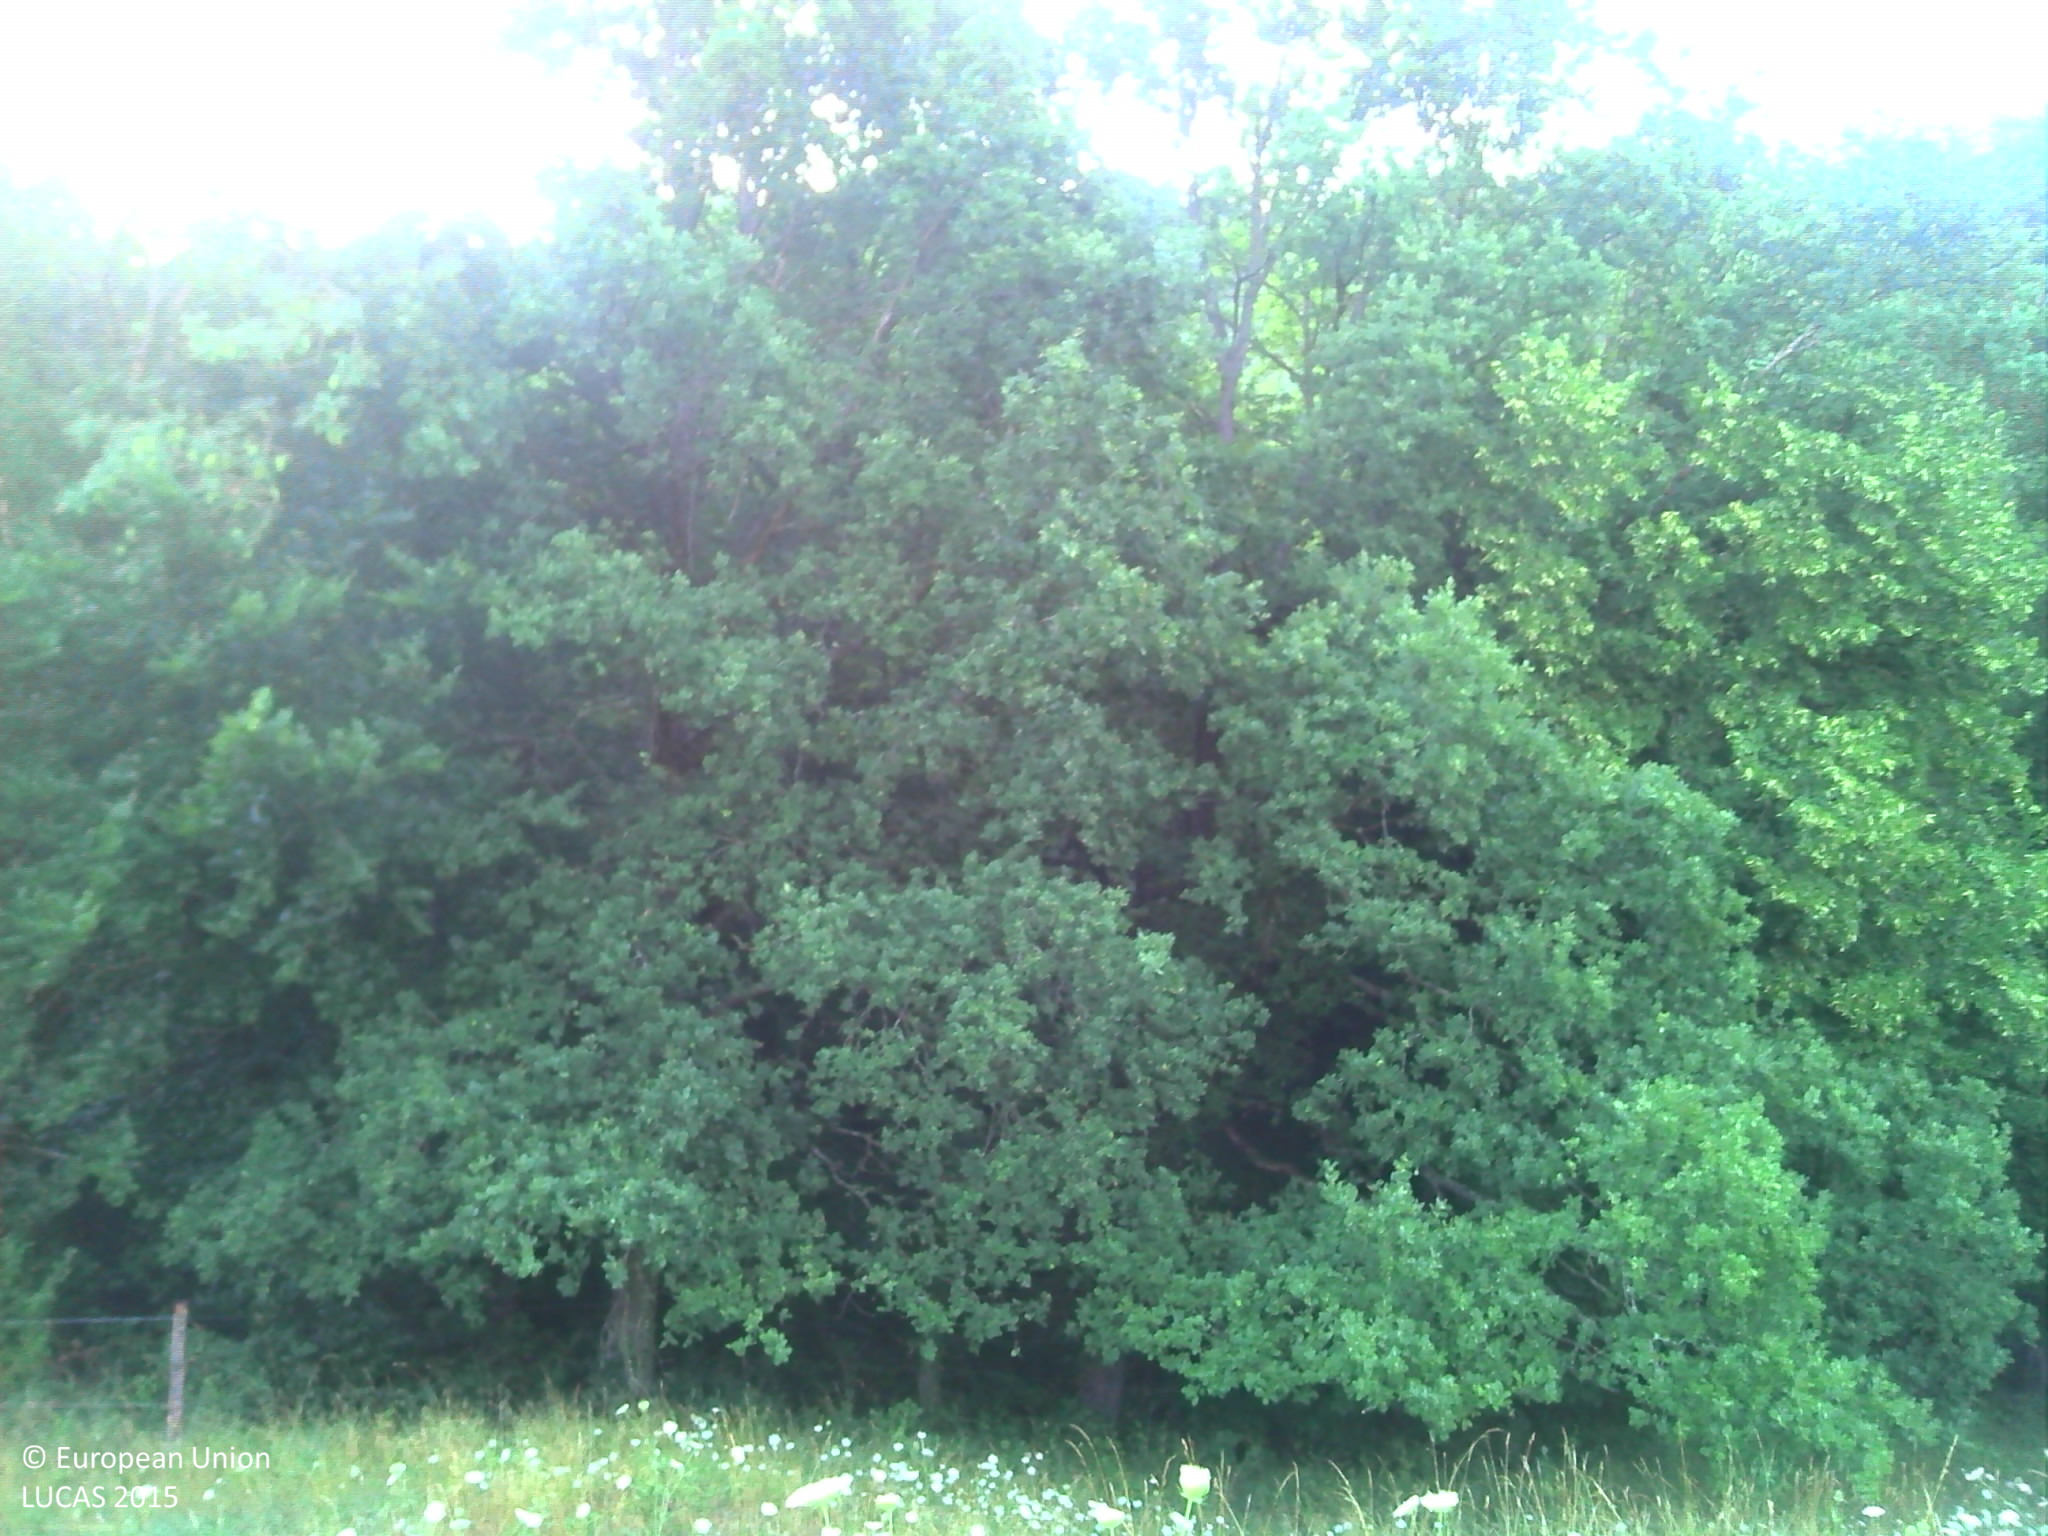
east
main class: Grassland
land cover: Grassland without tree/shrub cover
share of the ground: > 75 %
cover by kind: herbaceous plants 100 %
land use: Agriculture (excluding fallow land and kitchen gardens)
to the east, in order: Grassland without tree/shrub cover; Broadleaved woodland; Inland fresh running water; Broadleaved woodland; Grassland with sparse tree/shrub cover; Pine dominated mixed woodland; Dry stone walls; Pine dominated mixed woodland; Rock outcrops; Pine dominated mixed woodland; Fences; Grassland without tree/shrub cover; Pine dominated mixed woodland; Fences; Other bare soil
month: July
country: FR
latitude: 45.0523
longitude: 3.8203
